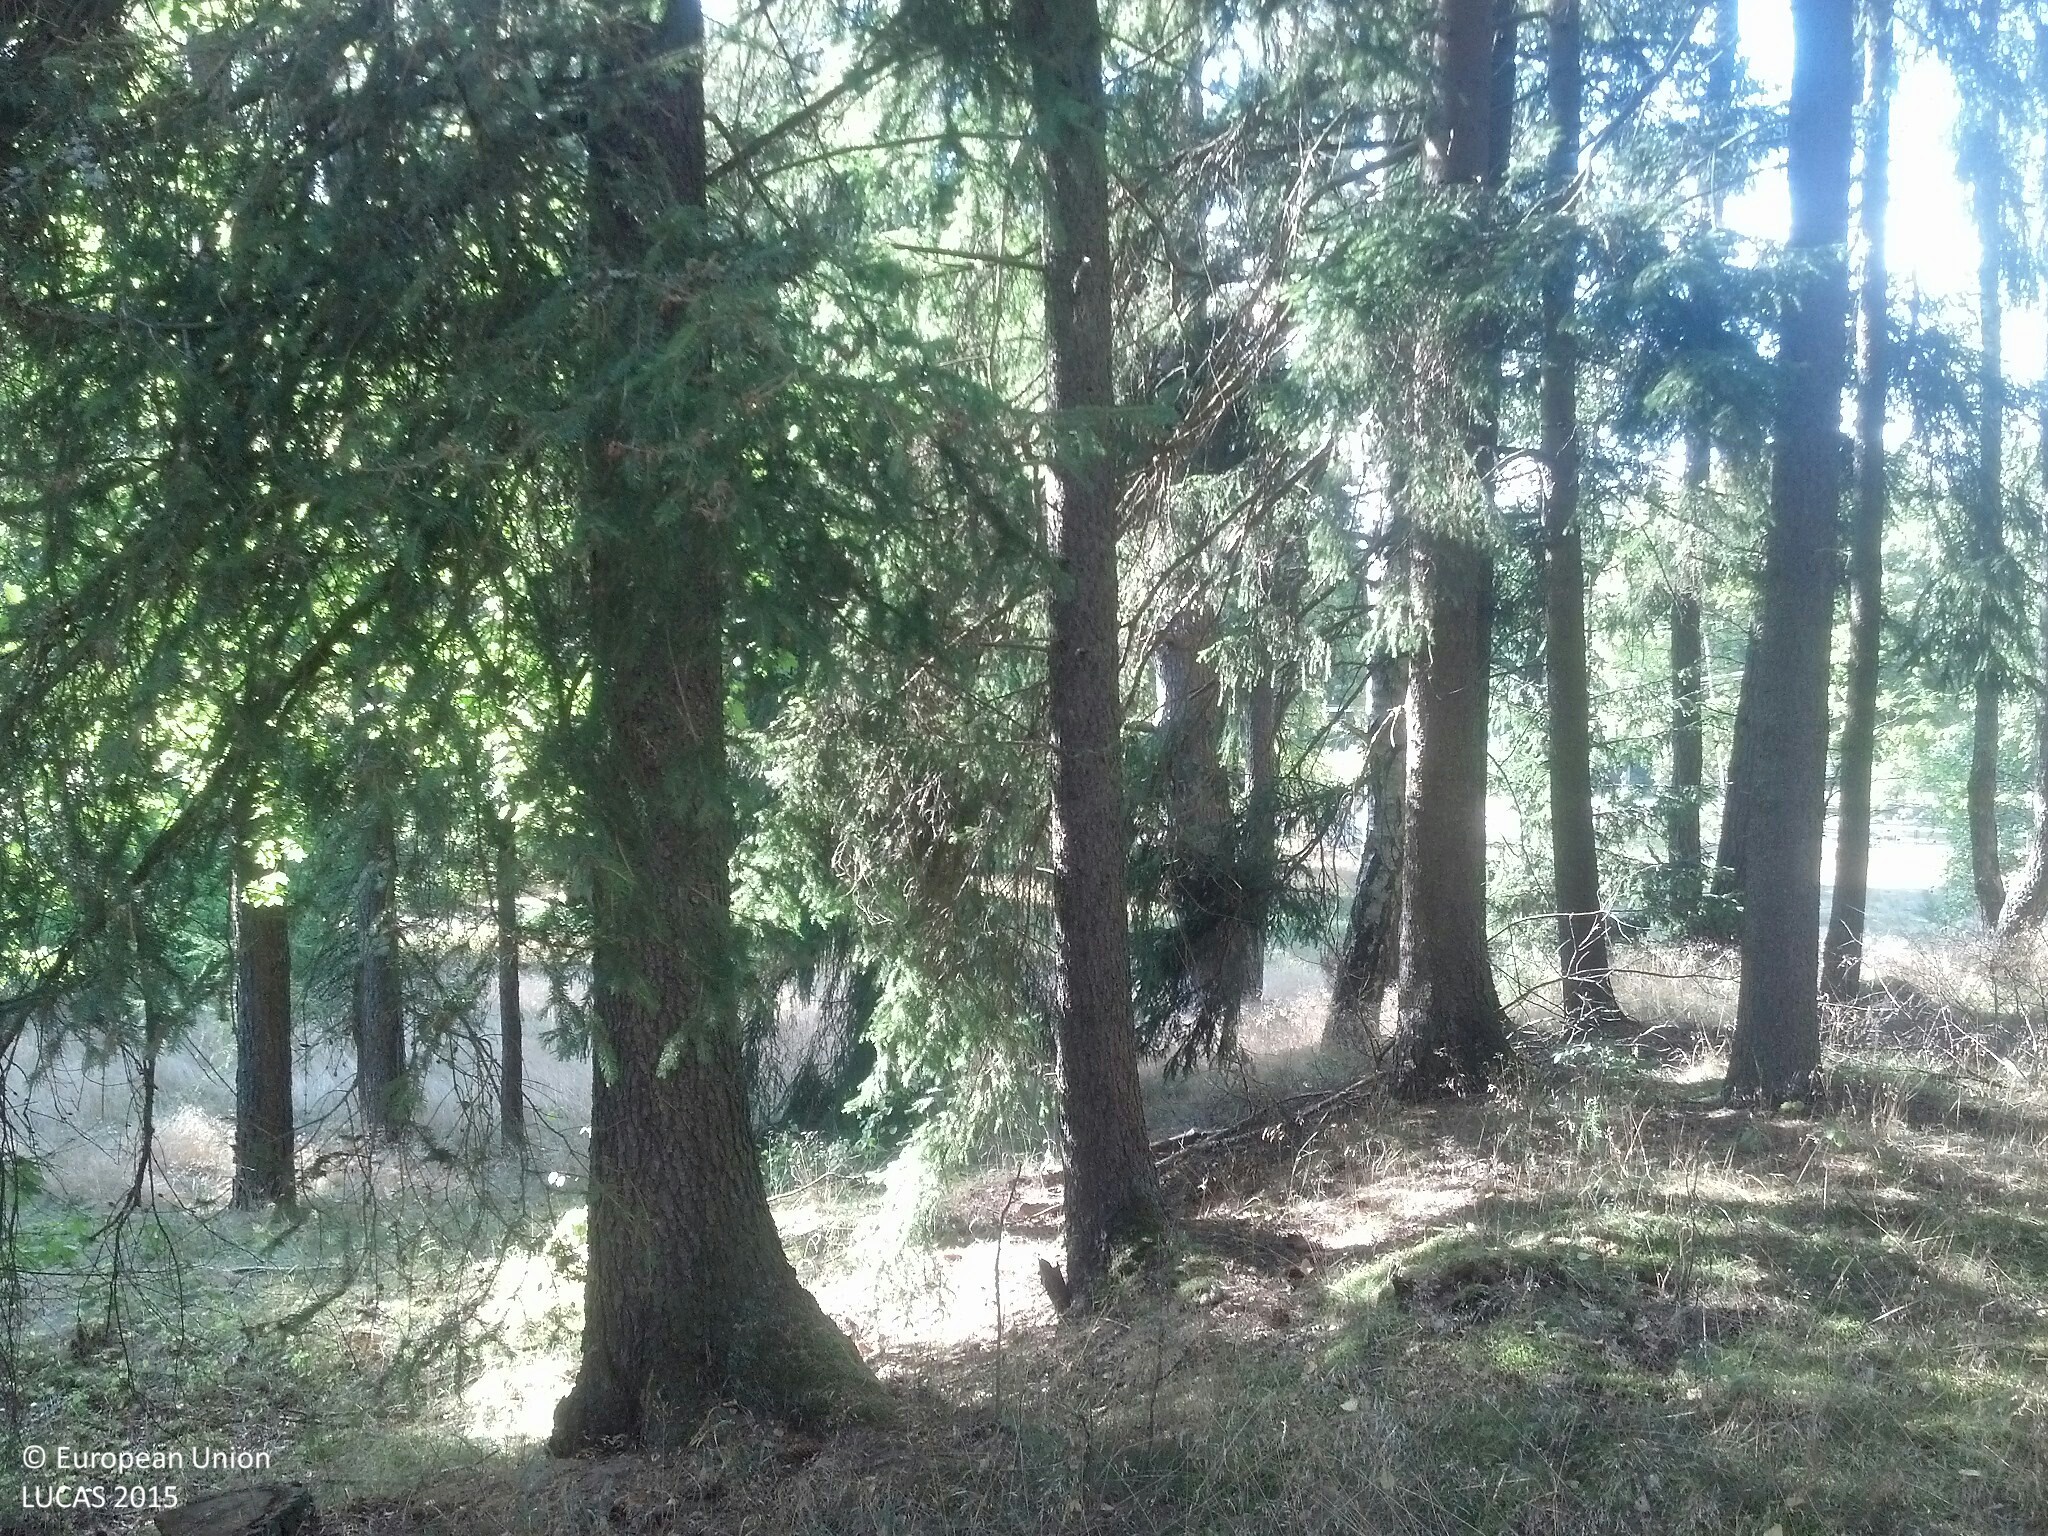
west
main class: Woodland
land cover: Pine dominated mixed woodland
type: hemiboreal forest and nemoral coniferous forest and mixed broadleaved-coniferous forest
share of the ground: > 75 %
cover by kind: coniferous forest trees 60 %, broadleaved forest trees 25 %, herbaceous plants 10 %, shrubs 5 %
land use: Forestry
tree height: > 5 m
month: August
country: PL
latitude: 53.9447
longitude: 17.2160
